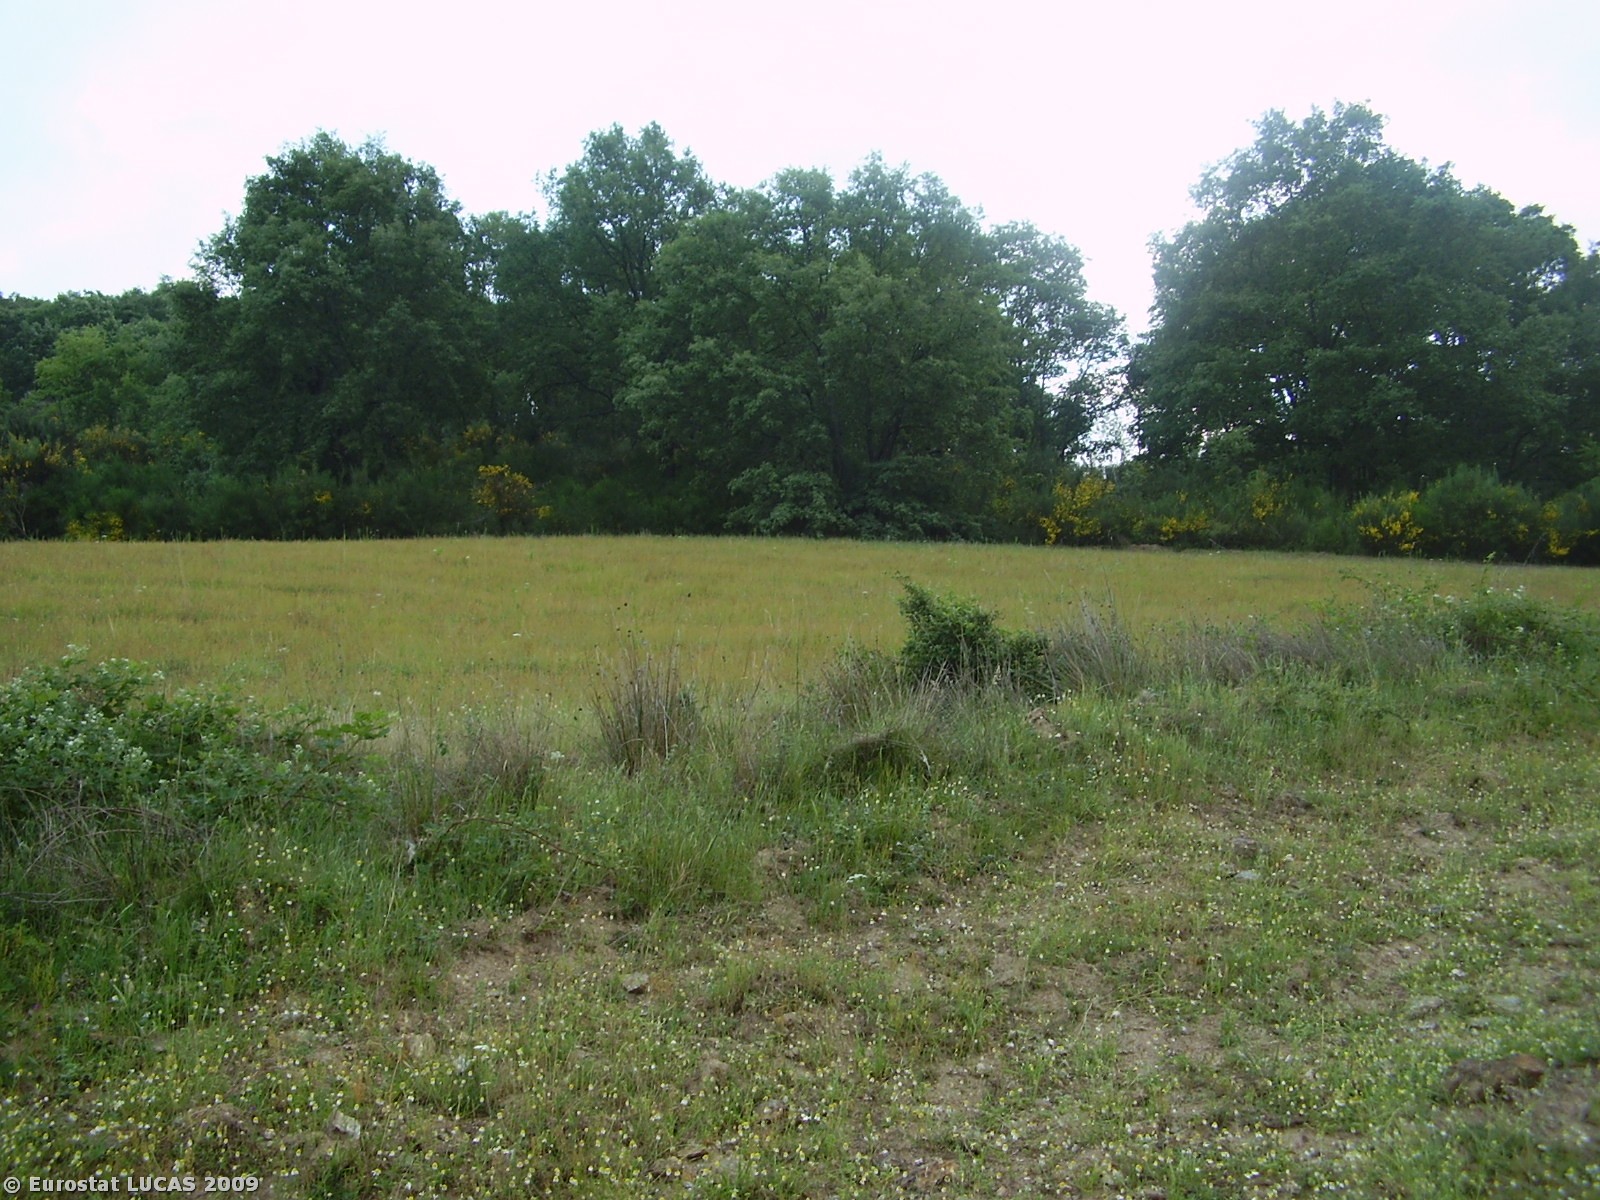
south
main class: Grassland
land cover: Grassland without tree/shrub cover
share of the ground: > 75 %
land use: Forestry
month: June
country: PT
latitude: 41.6595
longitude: -6.8170
